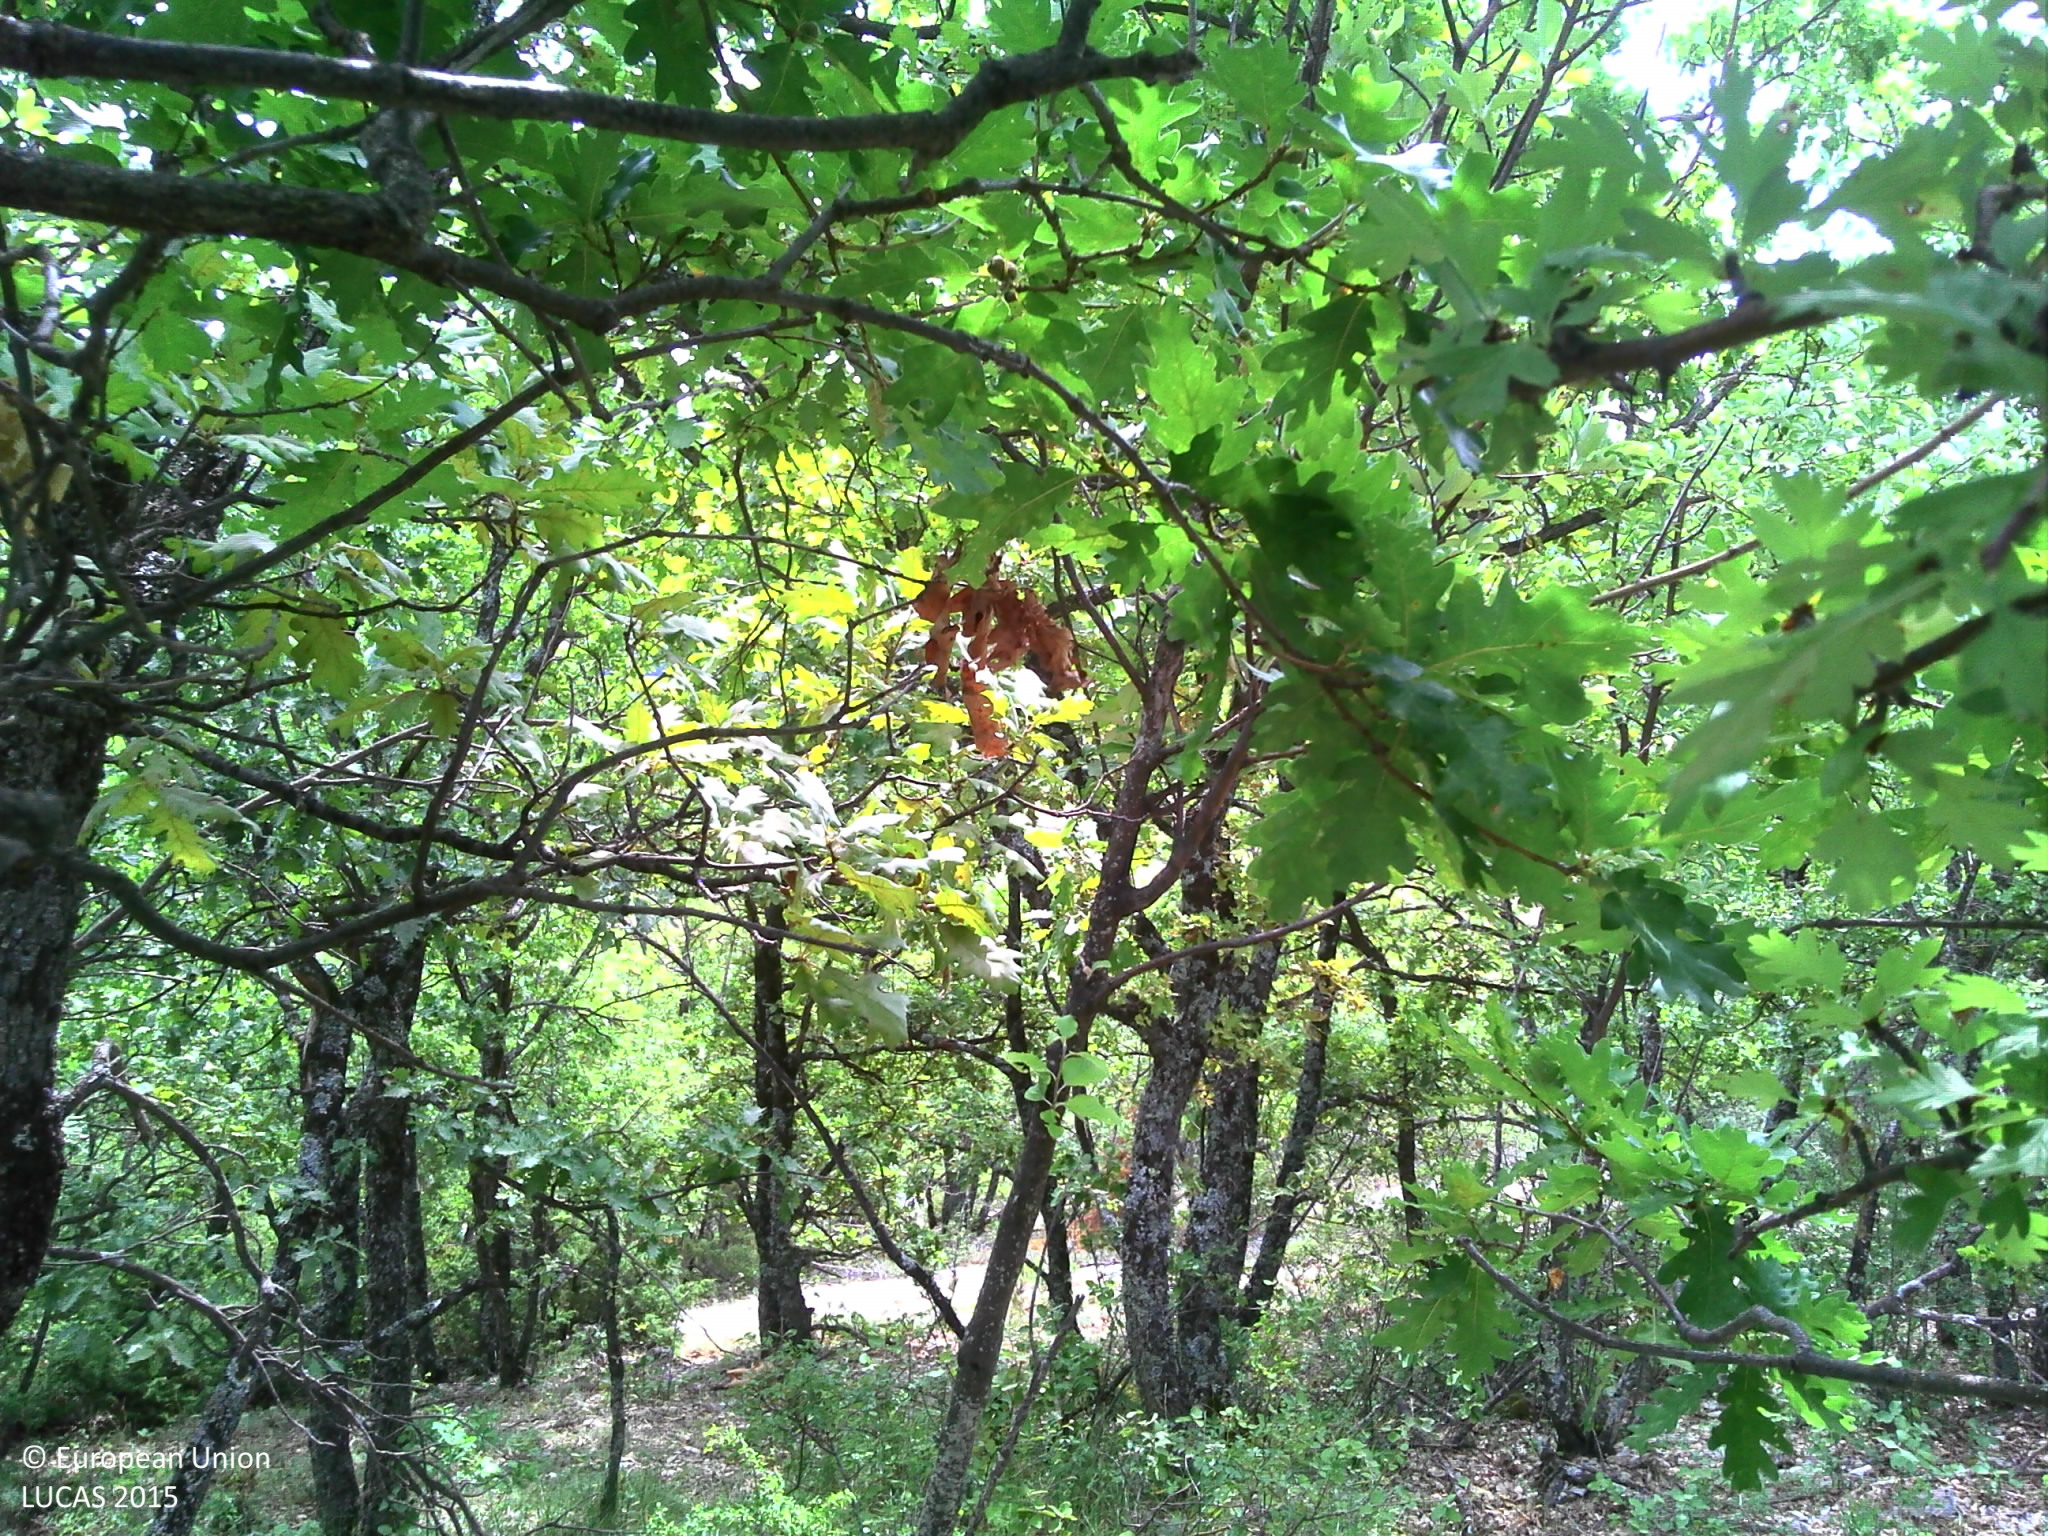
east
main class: Woodland
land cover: Broadleaved woodland
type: acidophilous oak and oak-birch forest
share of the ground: > 75 %
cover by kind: broadleaved forest trees 60 %, shrubs 15 %, unconsolidated bare surface 15 %, coniferous forest trees 5 %, herbaceous plants 5 %
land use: Semi-natural and natural areas not in use
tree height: < 5 m
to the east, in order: Broadleaved woodland; Rocks and stones; Broadleaved woodland; Rocks and stones; Pine dominated mixed woodland; Shrubland without tree cover
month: July
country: FR
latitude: 44.1220
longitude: 5.3968
